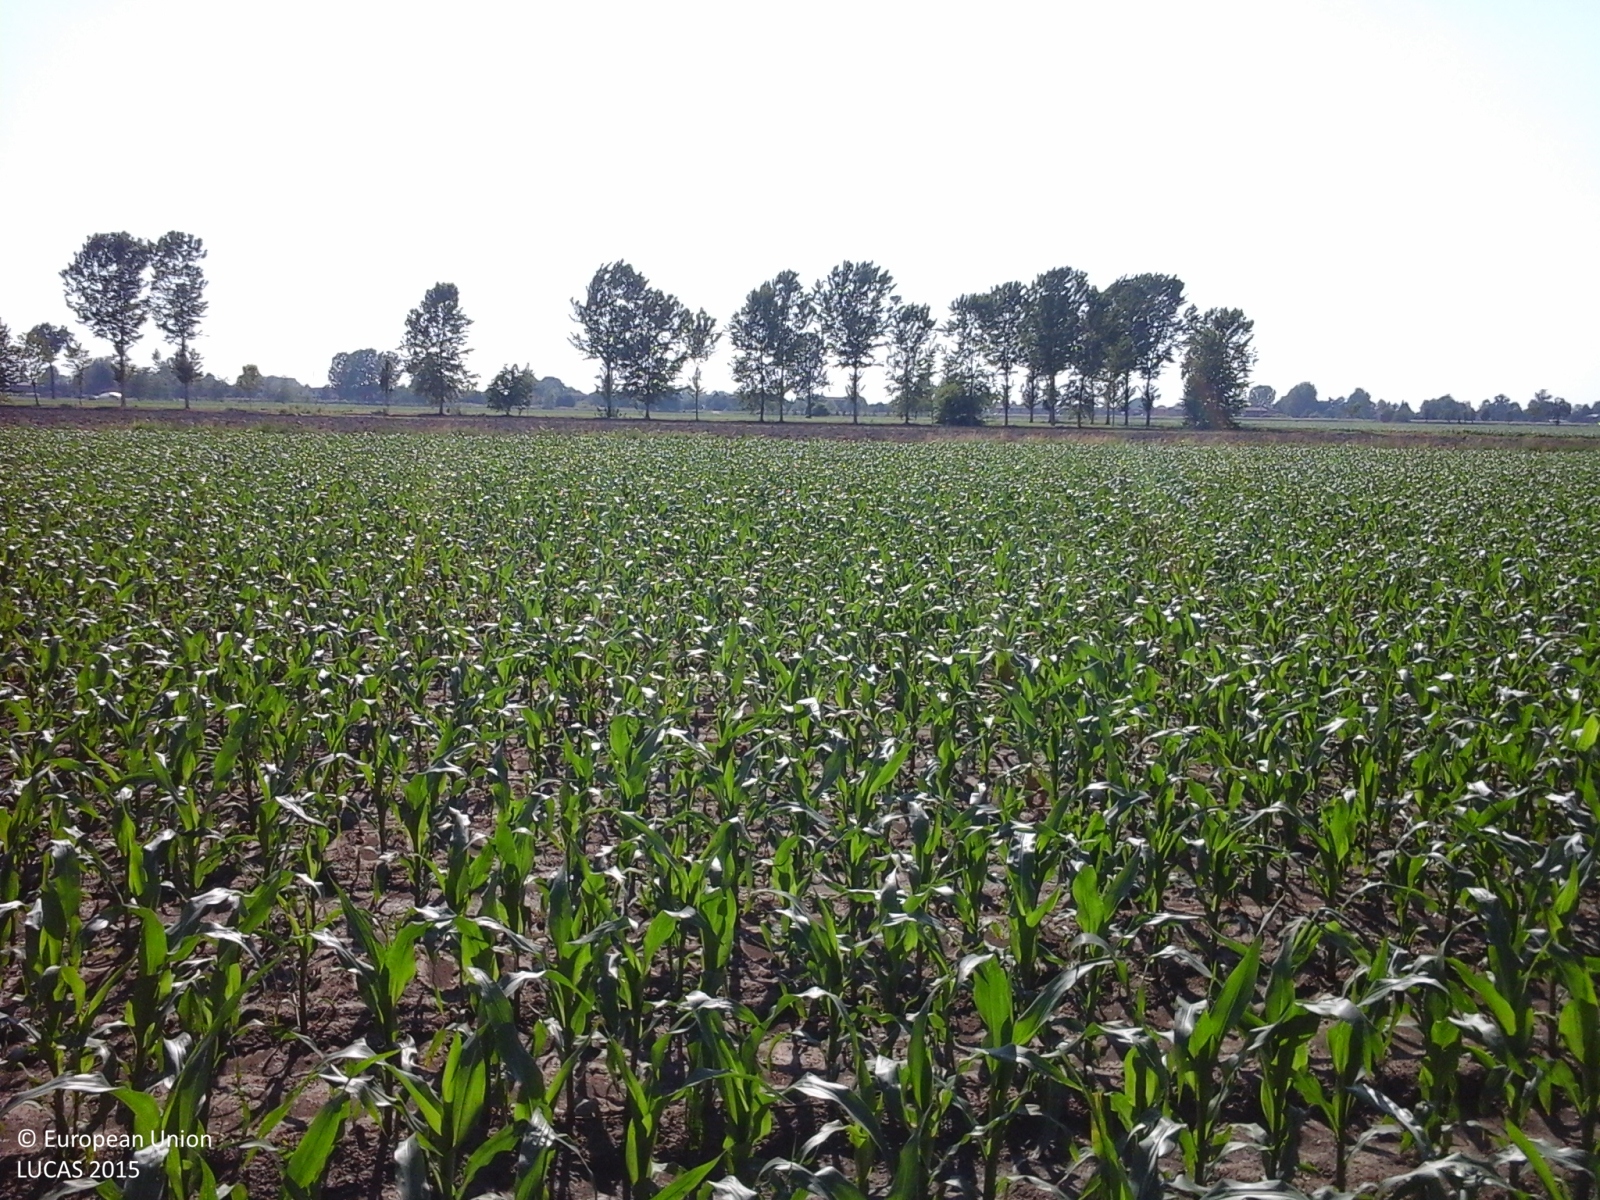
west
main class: Cropland
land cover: Maize
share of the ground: 25 - 50 %
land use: Agriculture (excluding fallow land and kitchen gardens)
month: May
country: IT
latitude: 45.3415
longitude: 9.6306
